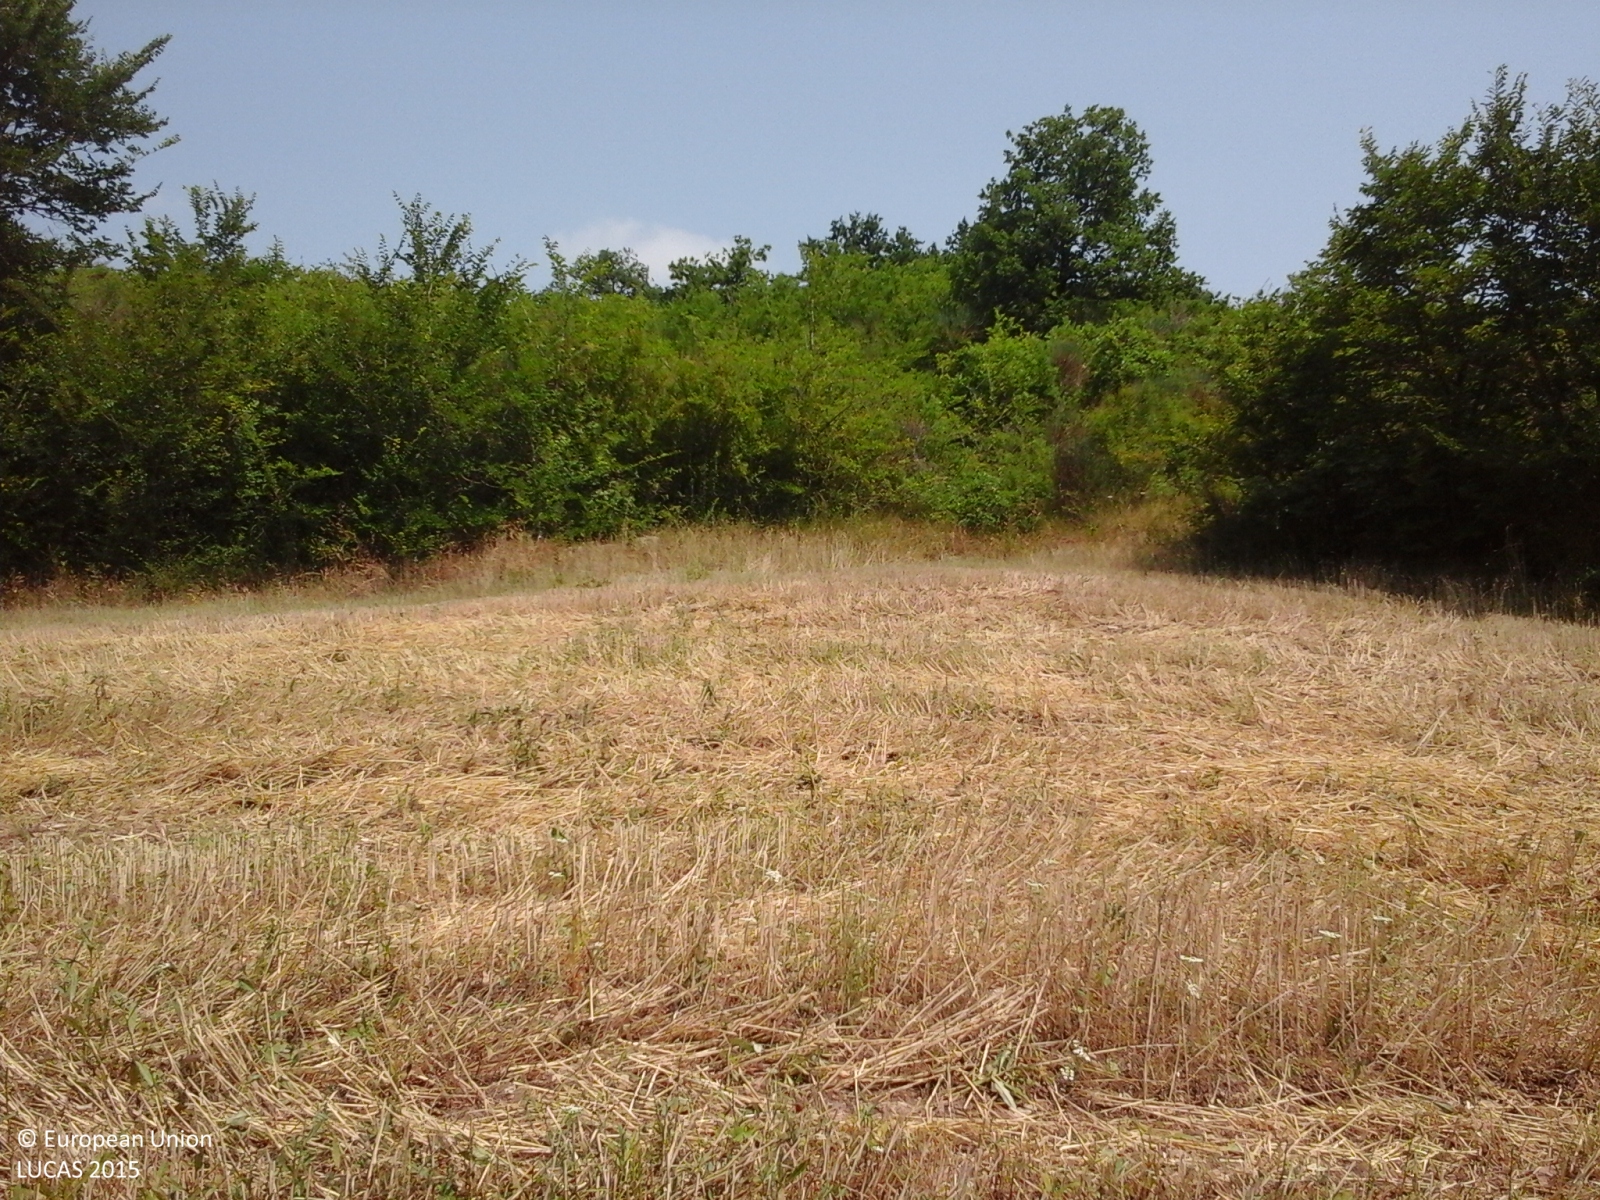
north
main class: Cropland
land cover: Common wheat
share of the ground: > 75 %
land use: Agriculture (excluding fallow land and kitchen gardens)
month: July
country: IT
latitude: 40.9491
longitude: 15.1241
